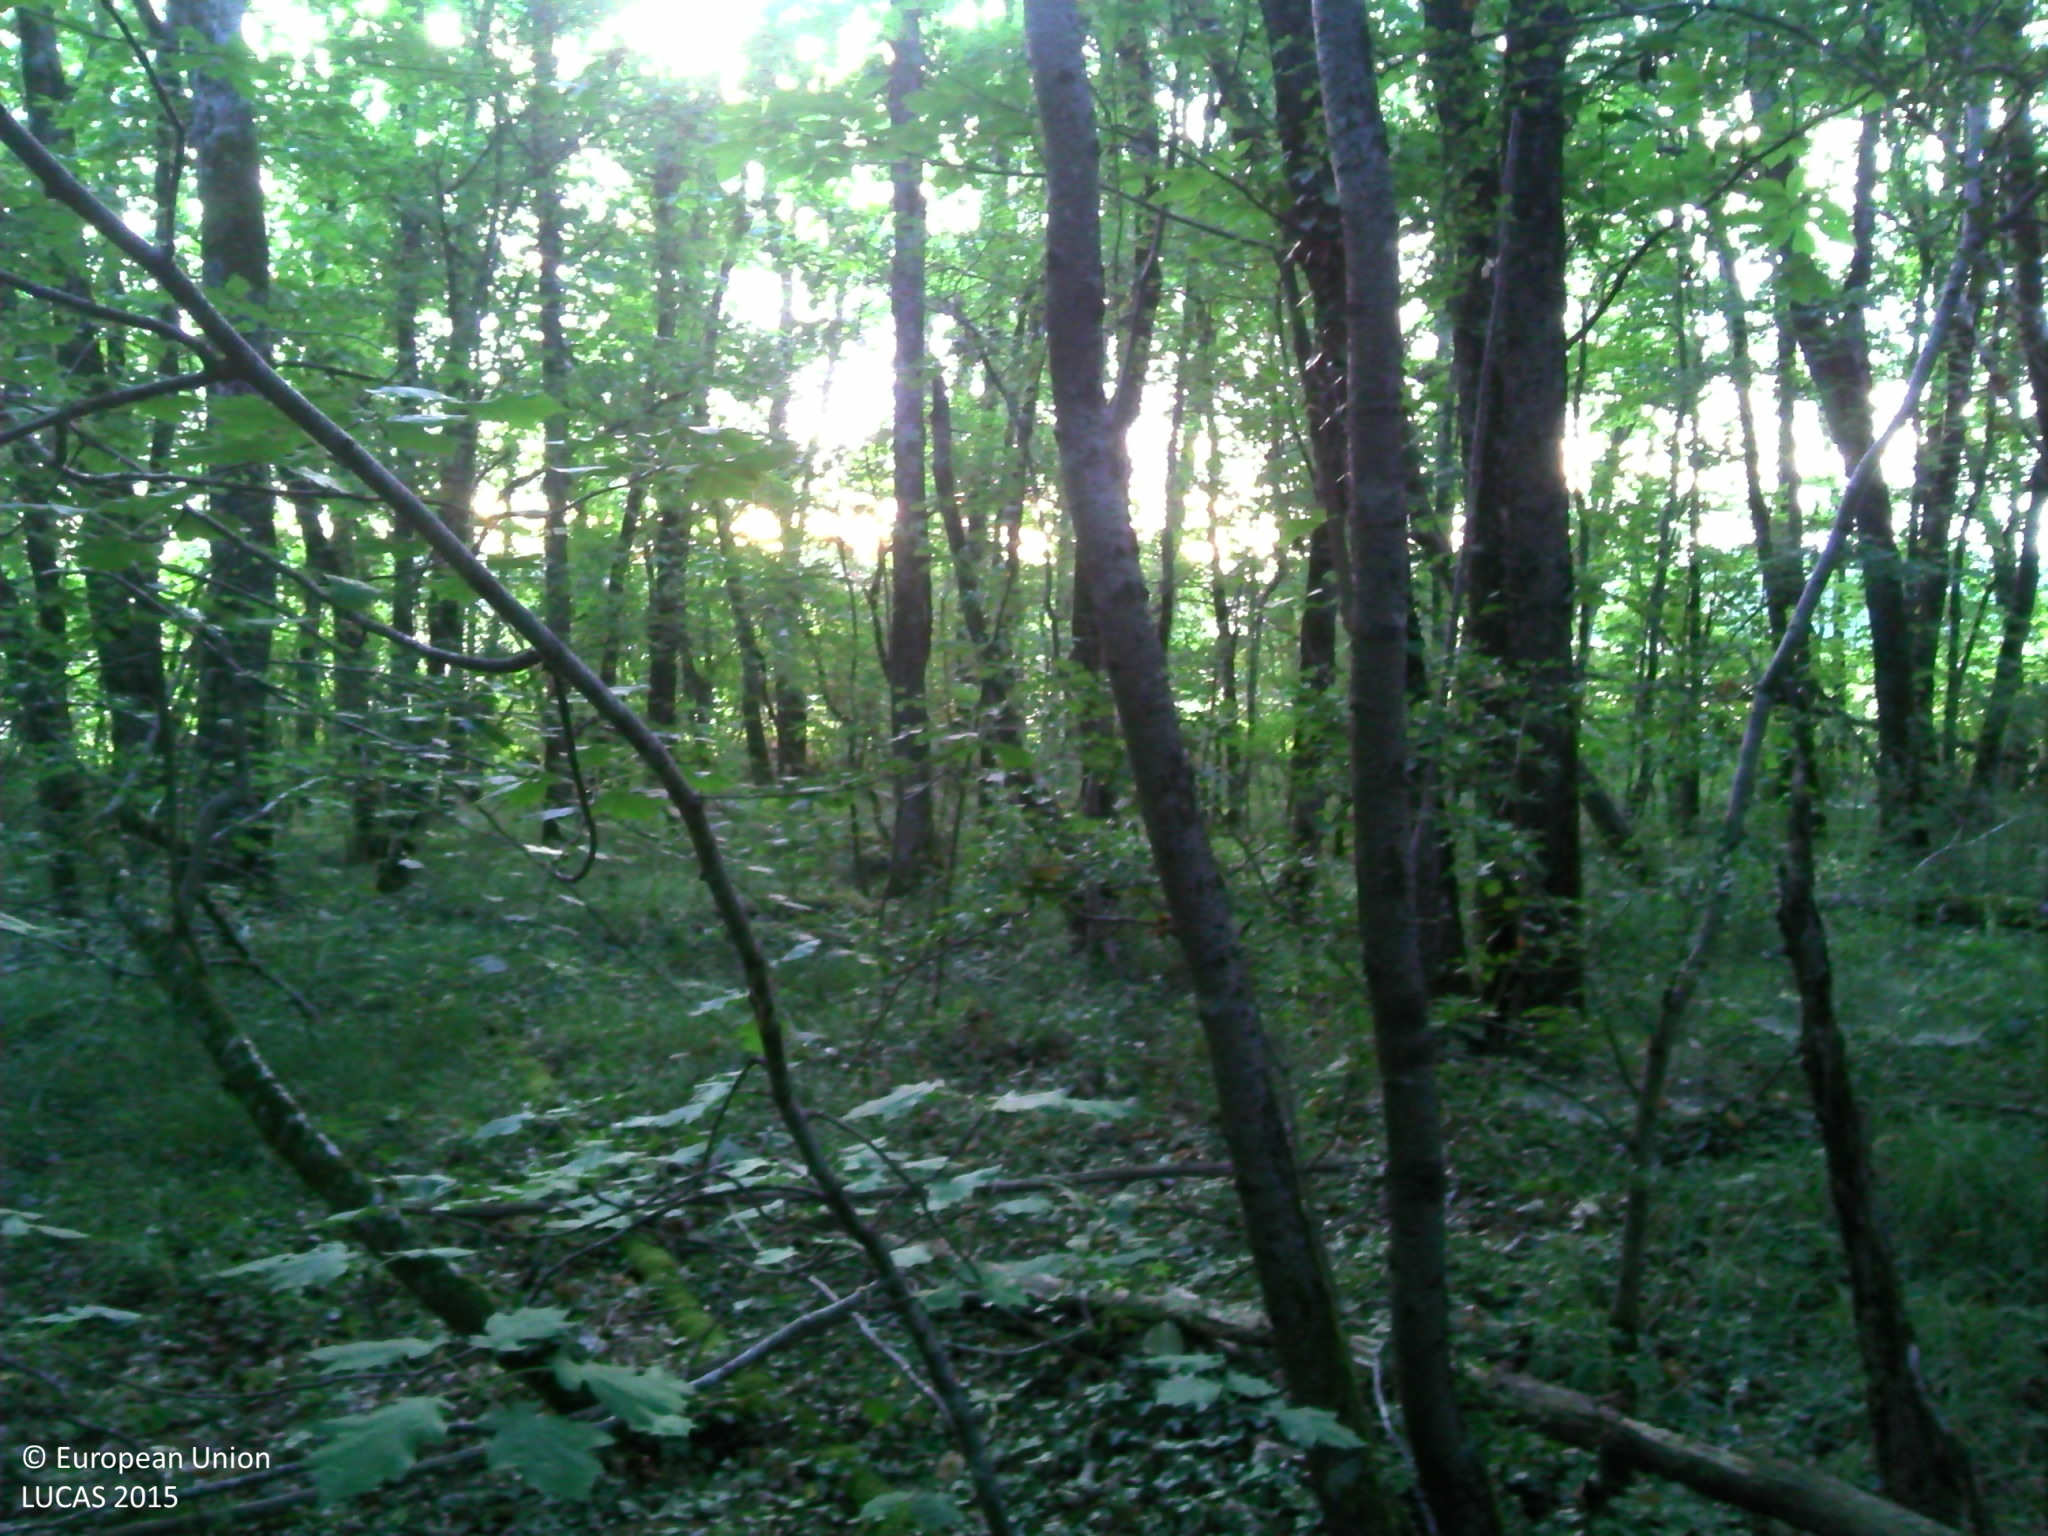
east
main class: Woodland
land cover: Broadleaved woodland
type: thermophilous deciduous forest
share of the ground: > 75 %
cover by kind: broadleaved forest trees 90 %, herbaceous plants 10 %
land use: Forestry
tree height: > 5 m
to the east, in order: Broadleaved woodland; Shrubland without tree cover; Common wheat; Paved roads, cycling and walking lanes; Electric lines; Grassland without tree/shrub cover; Electric lines; Single bushes/trees; Grassland without tree/shrub cover; Tracks; Grassland without tree/shrub cover
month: July
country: FR
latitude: 44.3270
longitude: 0.6519
